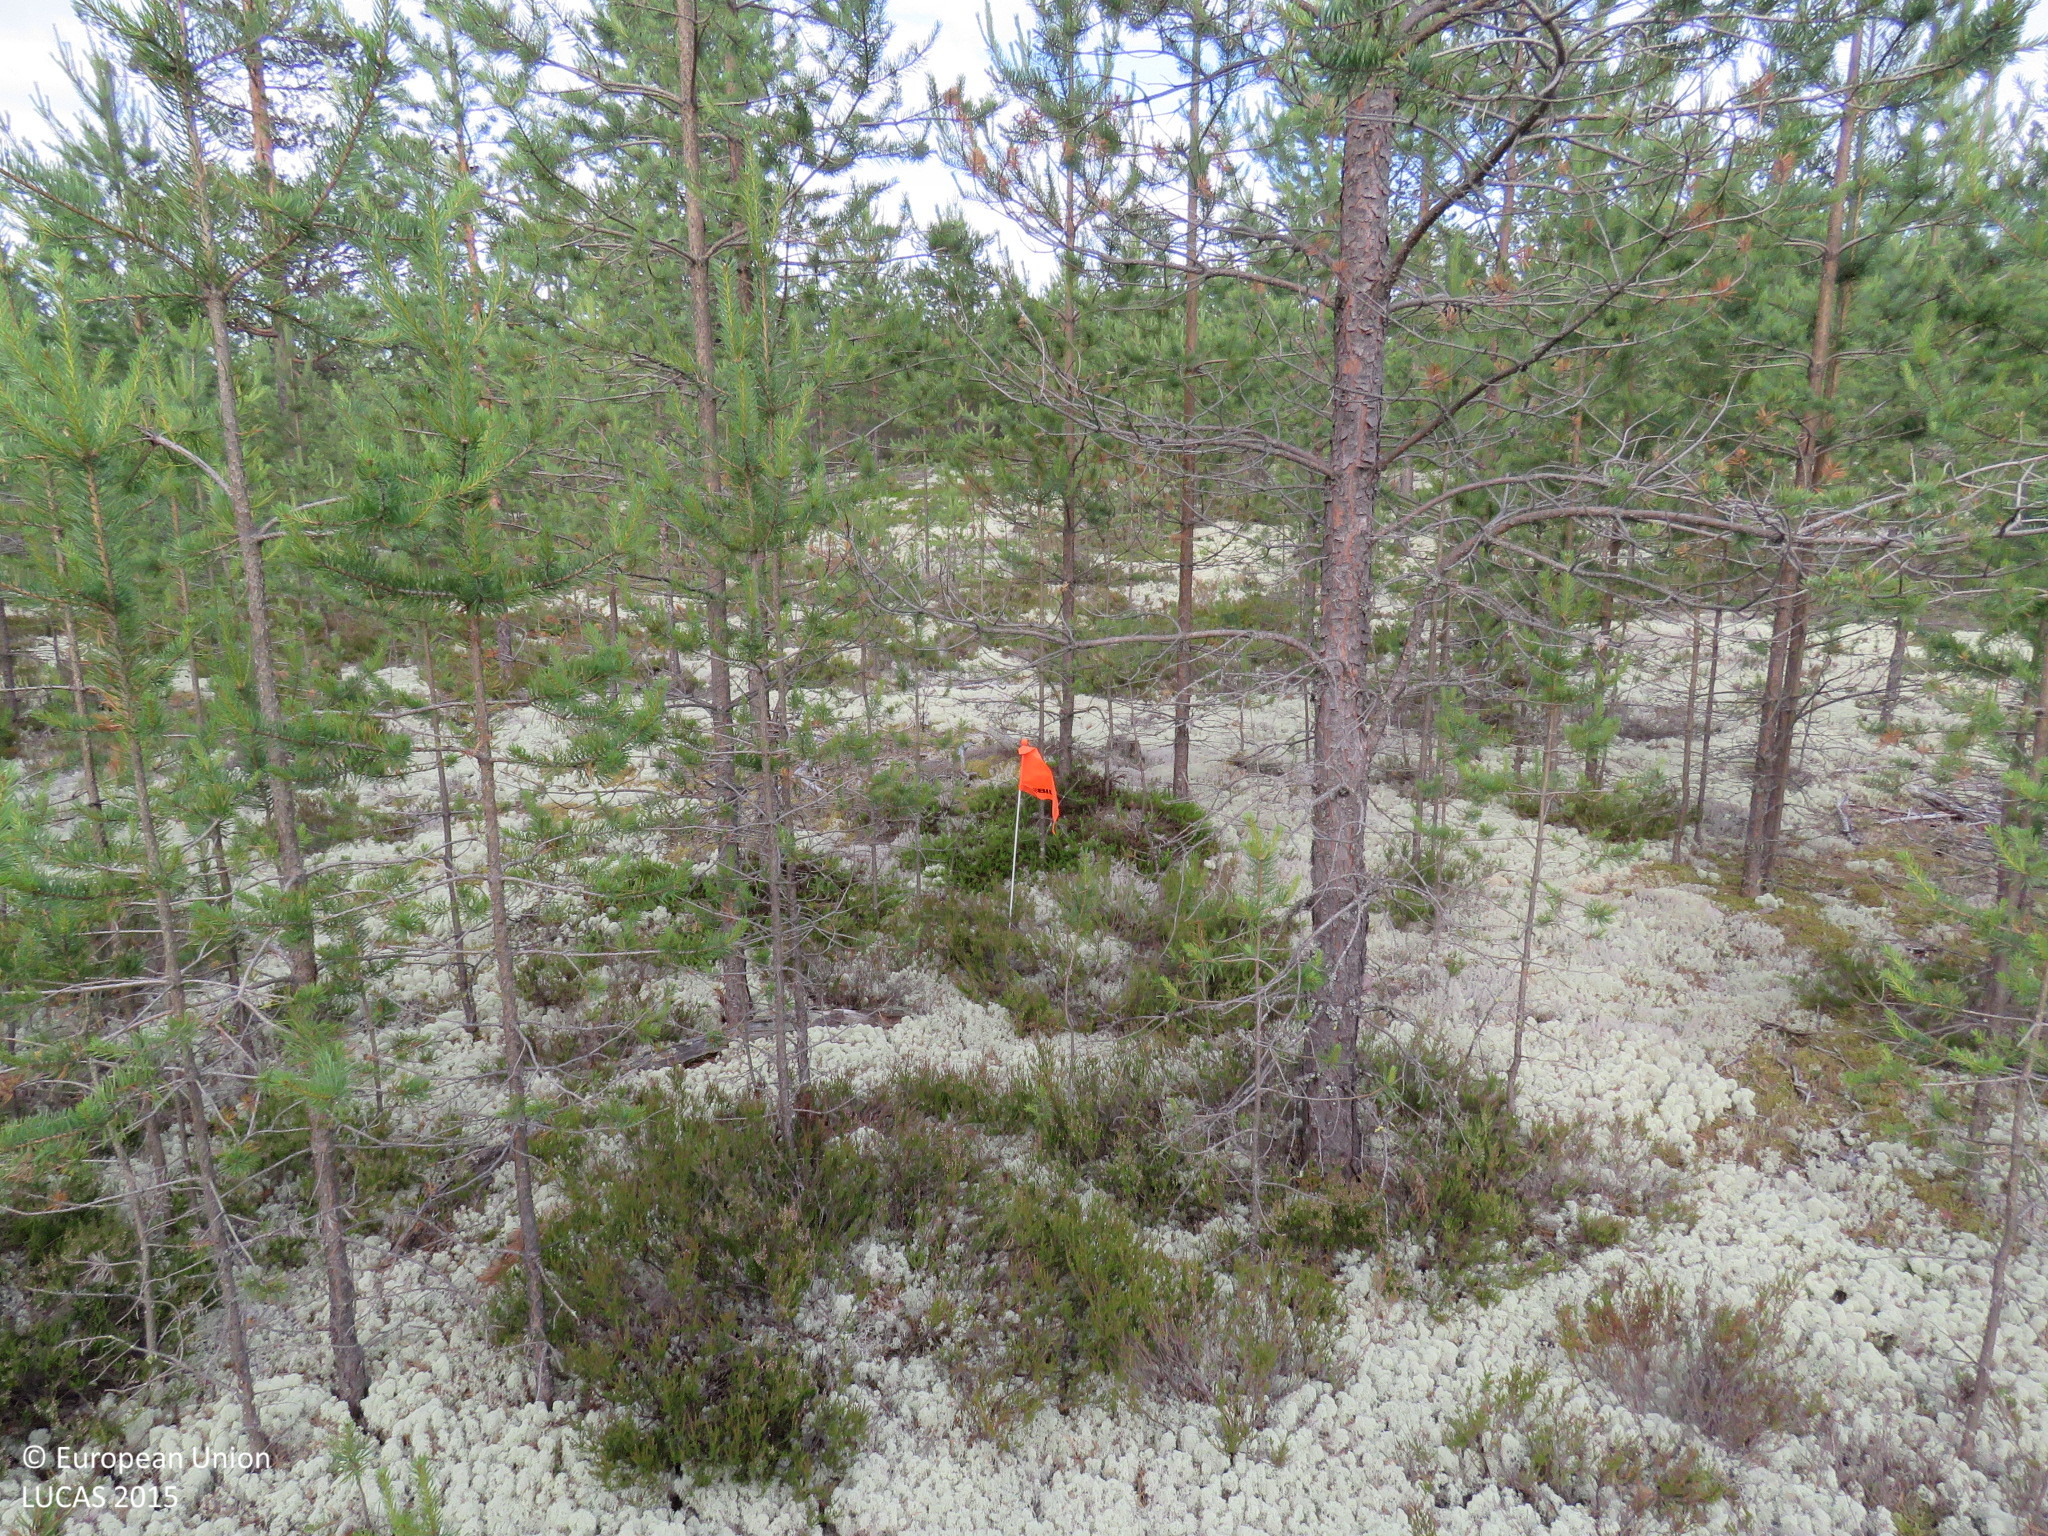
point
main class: Woodland
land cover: Pine dominated coniferous woodland
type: boreal forest
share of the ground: > 75 %
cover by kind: coniferous forest trees 75 %, lichens and mosses 20 %, shrubs 5 %
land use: Forestry
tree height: > 5 m
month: July
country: FI
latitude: 64.6077
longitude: 26.4350
